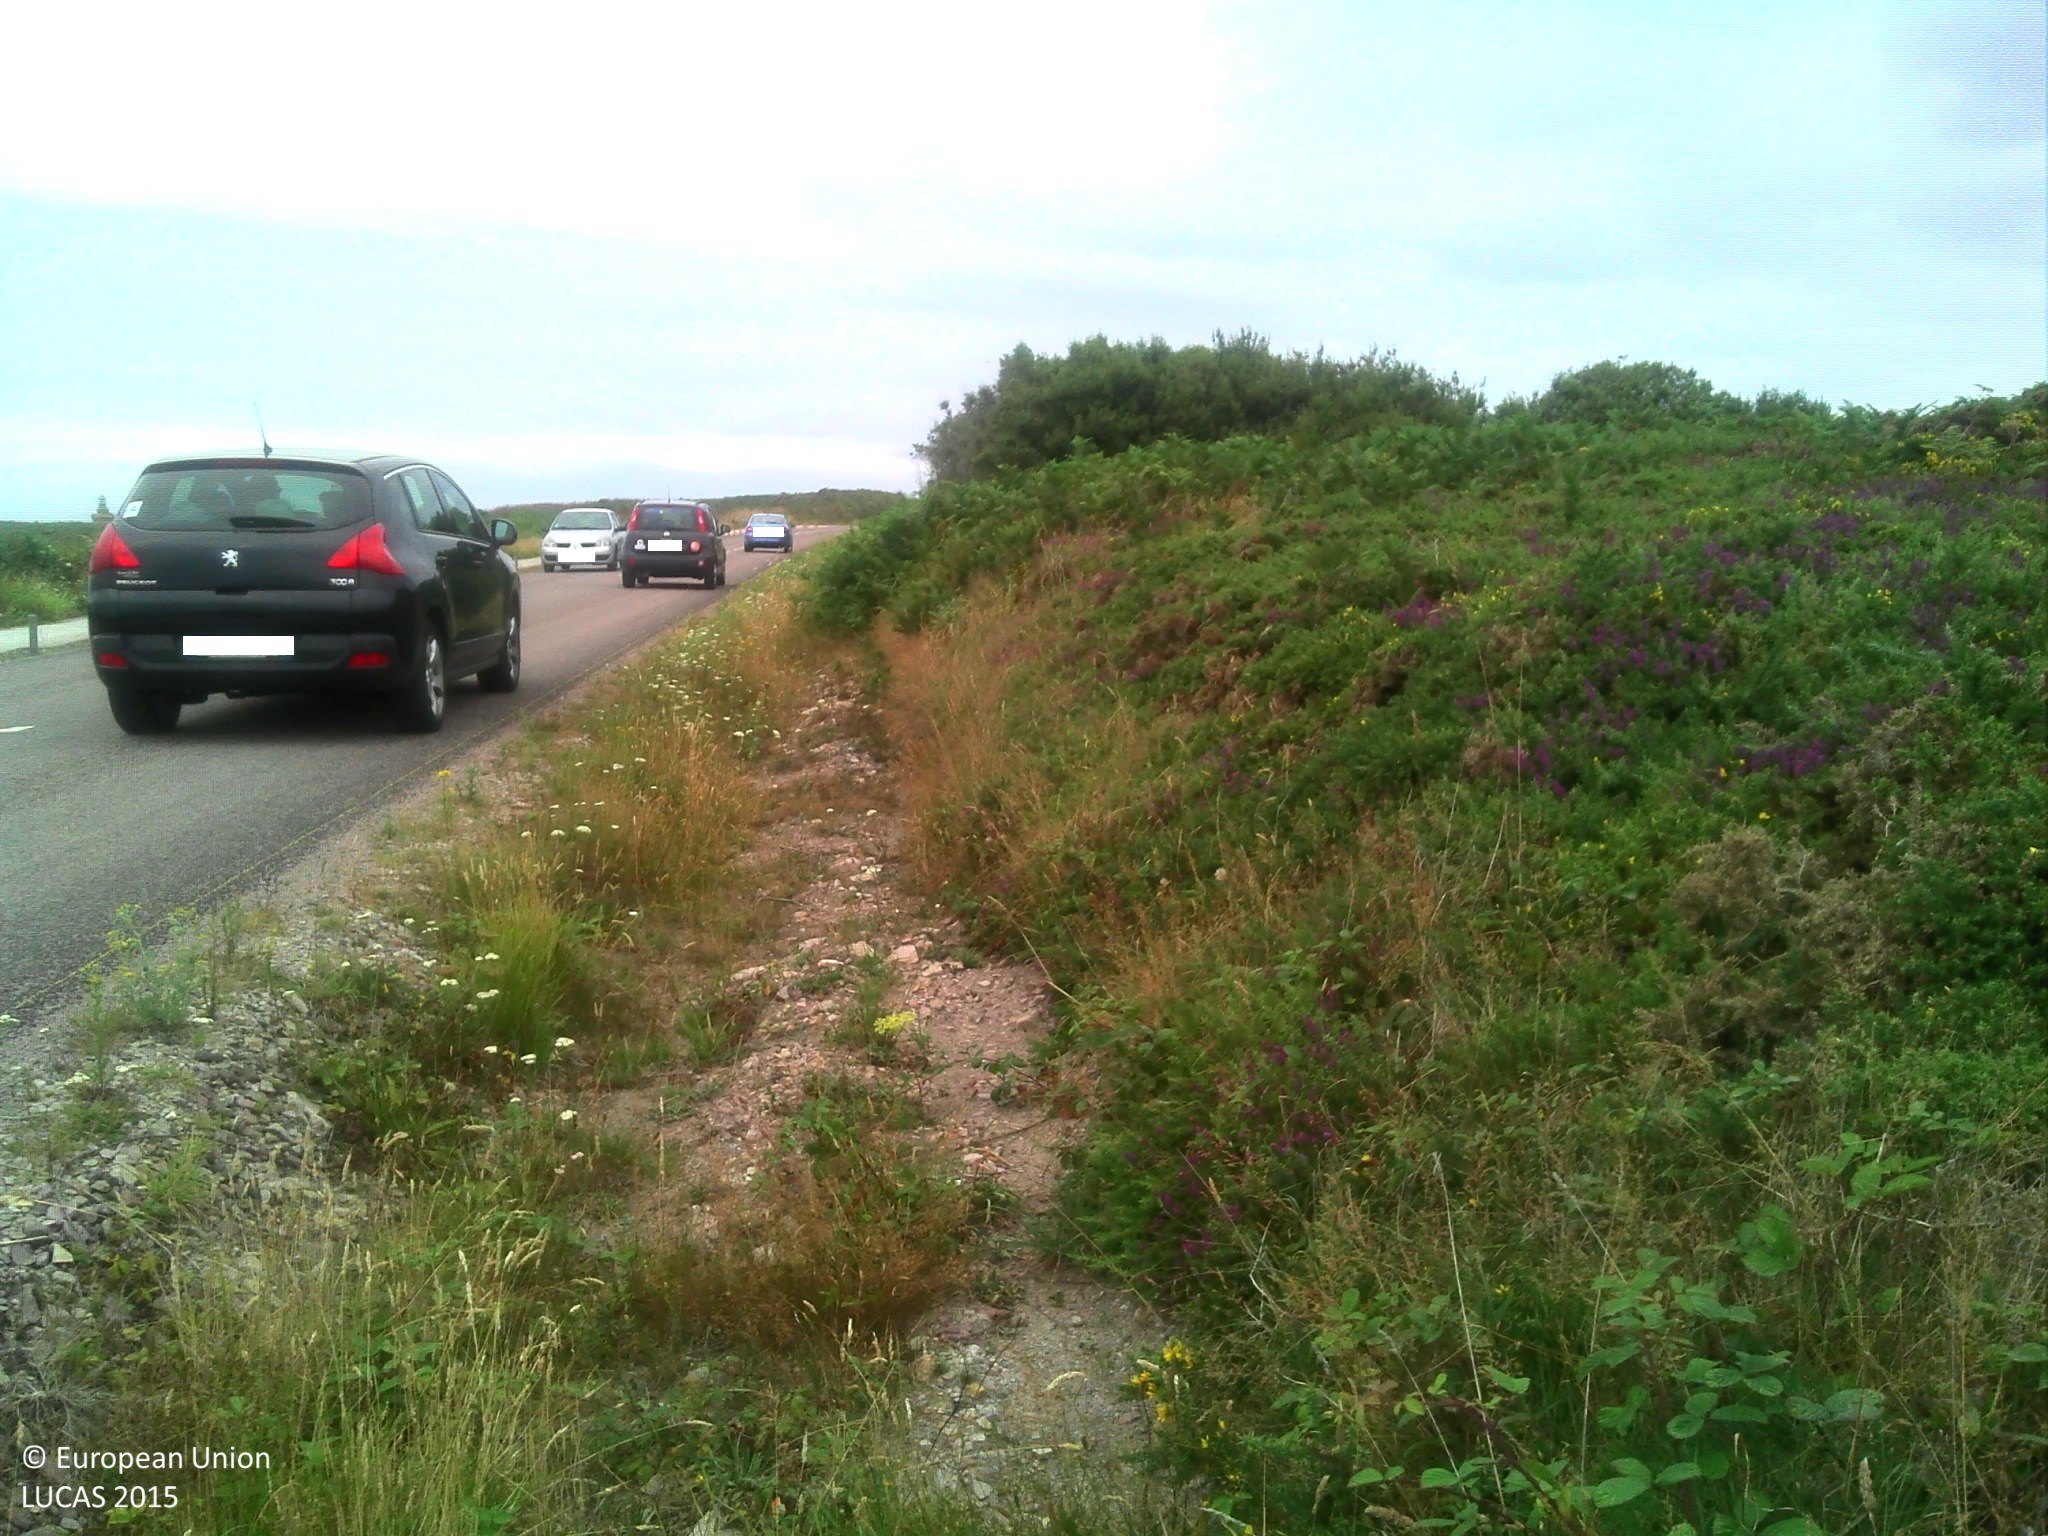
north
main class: Shrubland
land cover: Shrubland without tree cover
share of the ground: > 75 %
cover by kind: shrubs 95 %, herbaceous plants 5 %
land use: Semi-natural and natural areas not in use
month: July
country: FR
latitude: 48.6756
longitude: -2.3229
